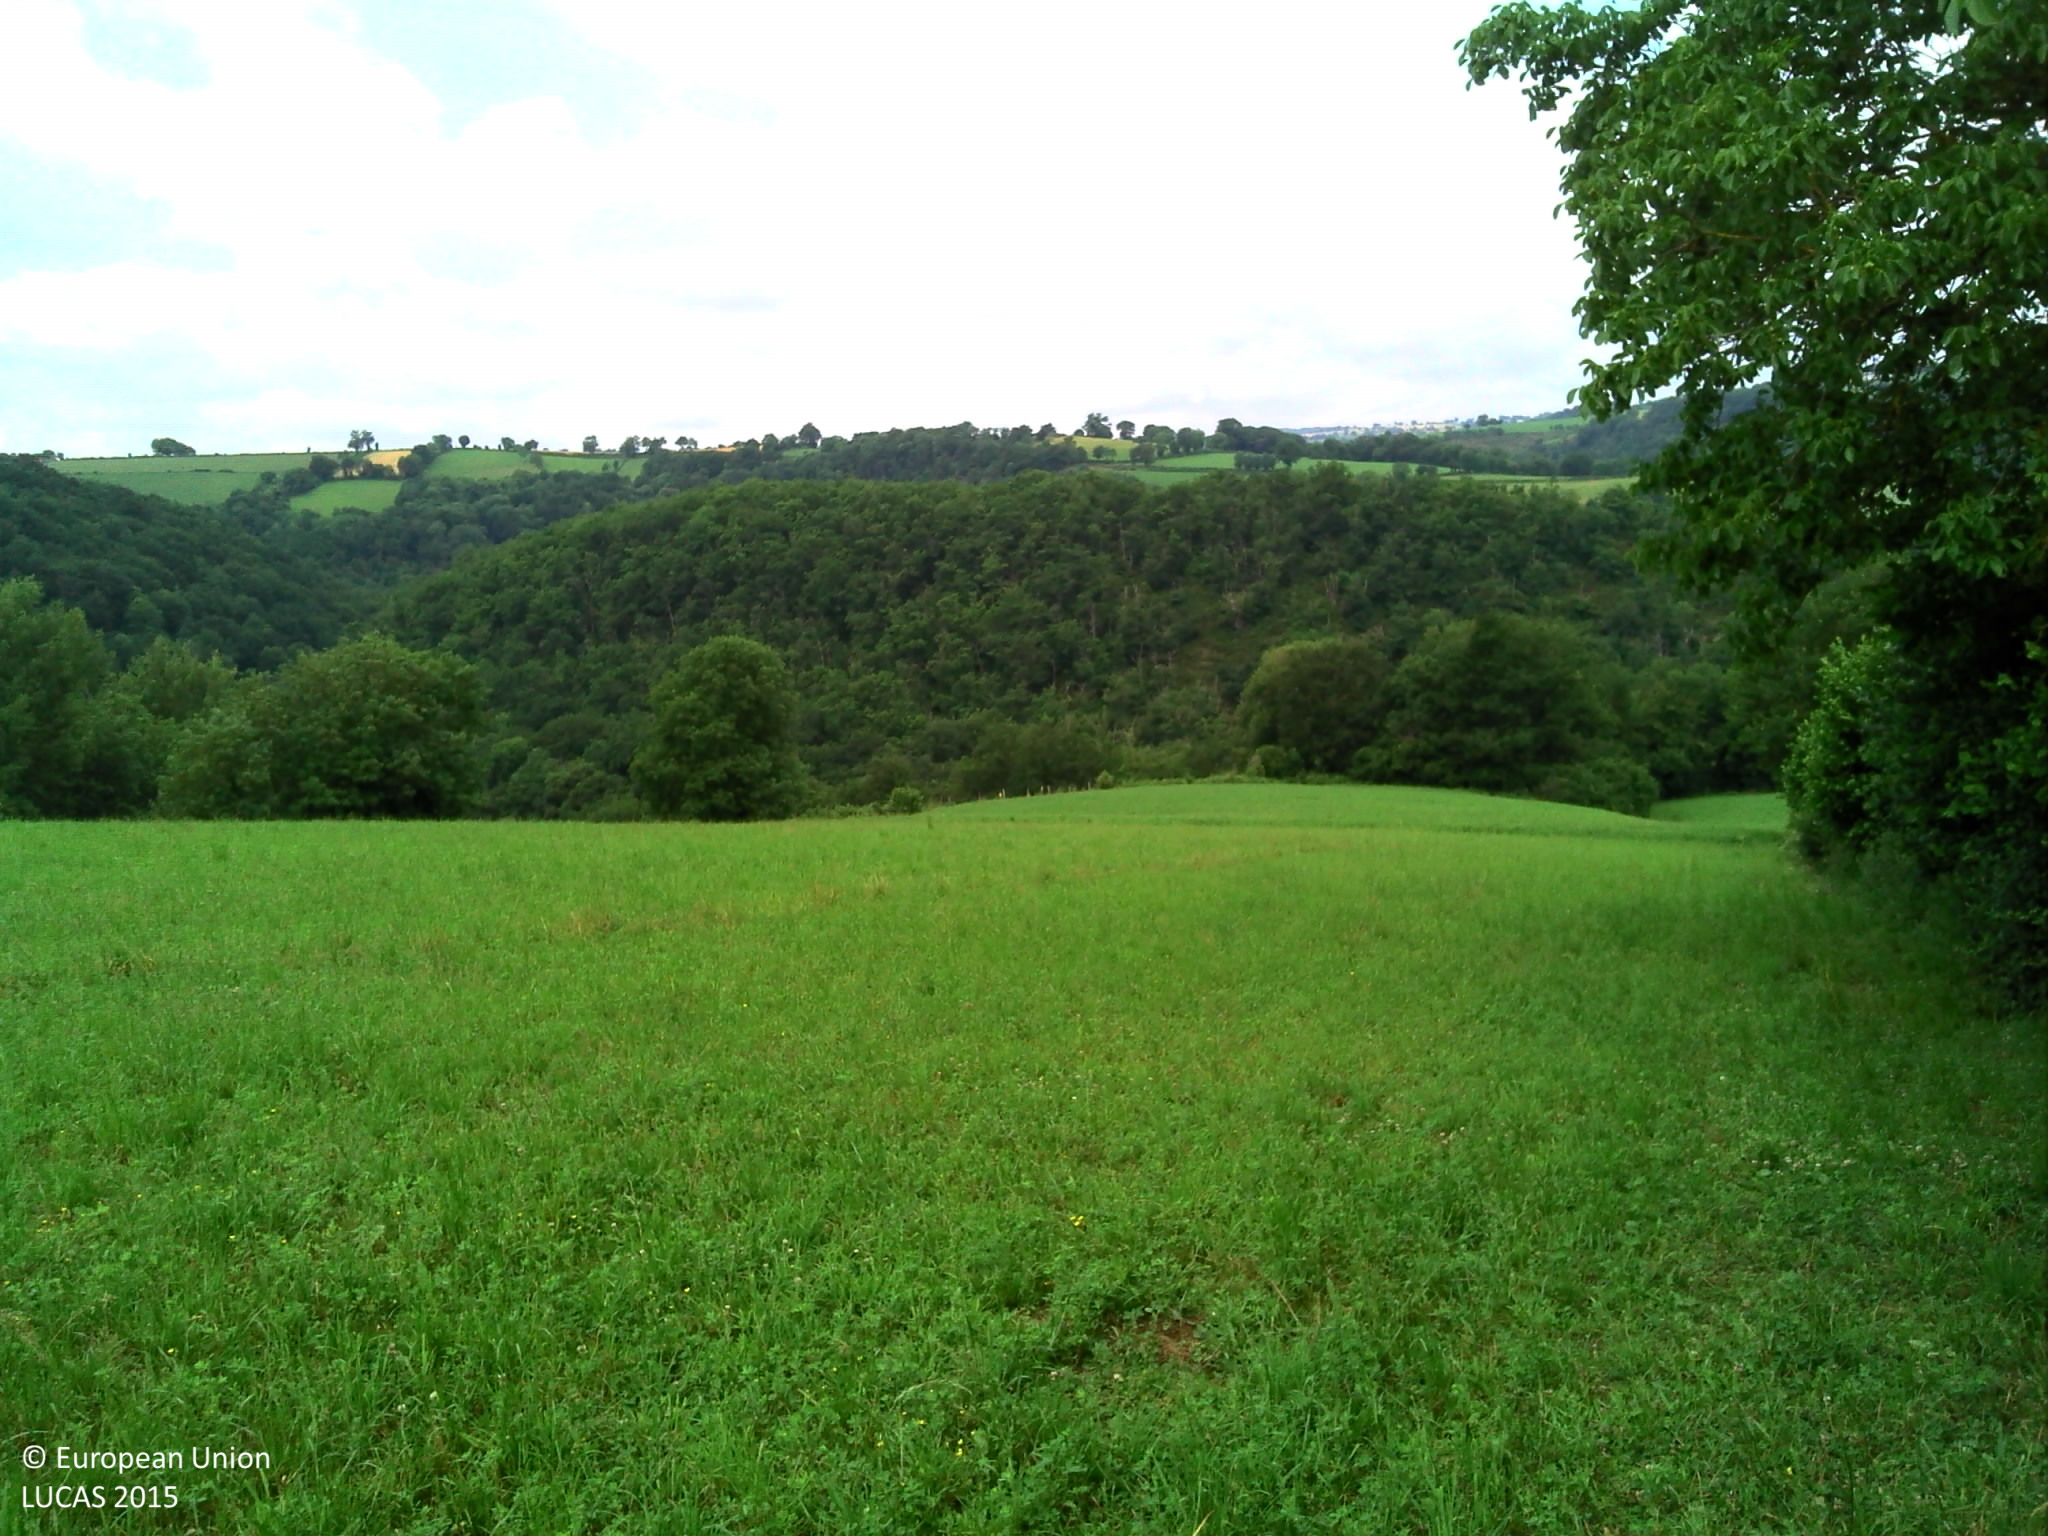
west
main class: Cropland
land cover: Barley
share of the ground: > 75 %
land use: Agriculture (excluding fallow land and kitchen gardens)
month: June
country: FR
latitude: 44.2062
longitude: 2.5077
